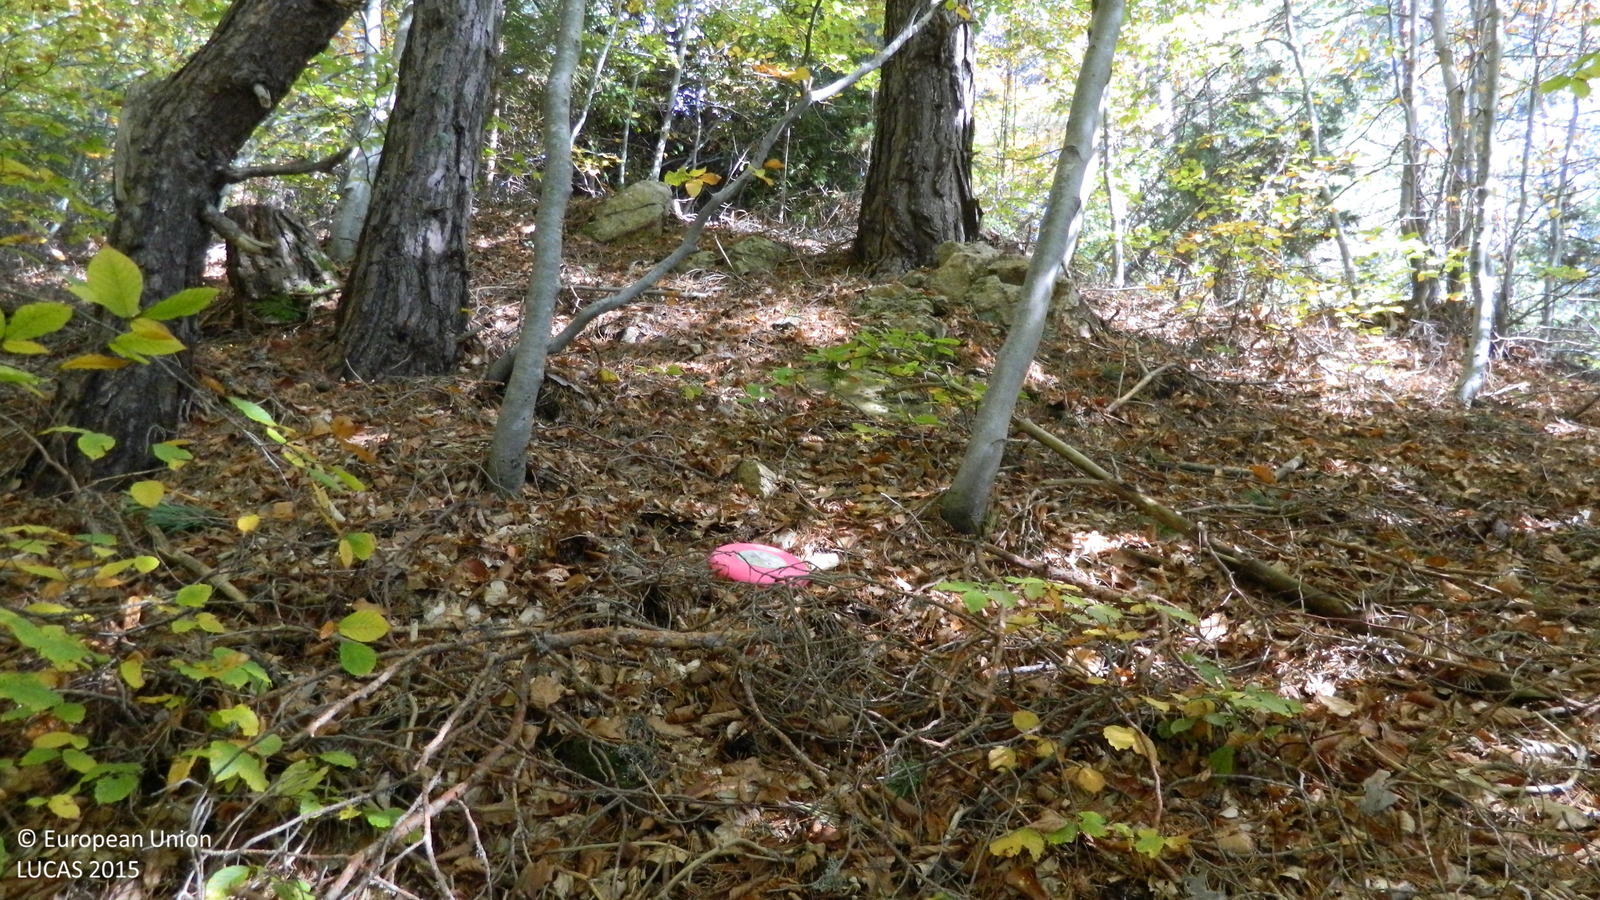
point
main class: Woodland
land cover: Pine dominated mixed woodland
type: hemiboreal forest and nemoral coniferous forest and mixed broadleaved-coniferous forest
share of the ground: > 75 %
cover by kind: coniferous forest trees 65 %, broadleaved forest trees 35 %
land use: Forestry
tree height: > 5 m
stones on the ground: < 10 %
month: October
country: BG
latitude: 41.4986
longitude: 24.5957
